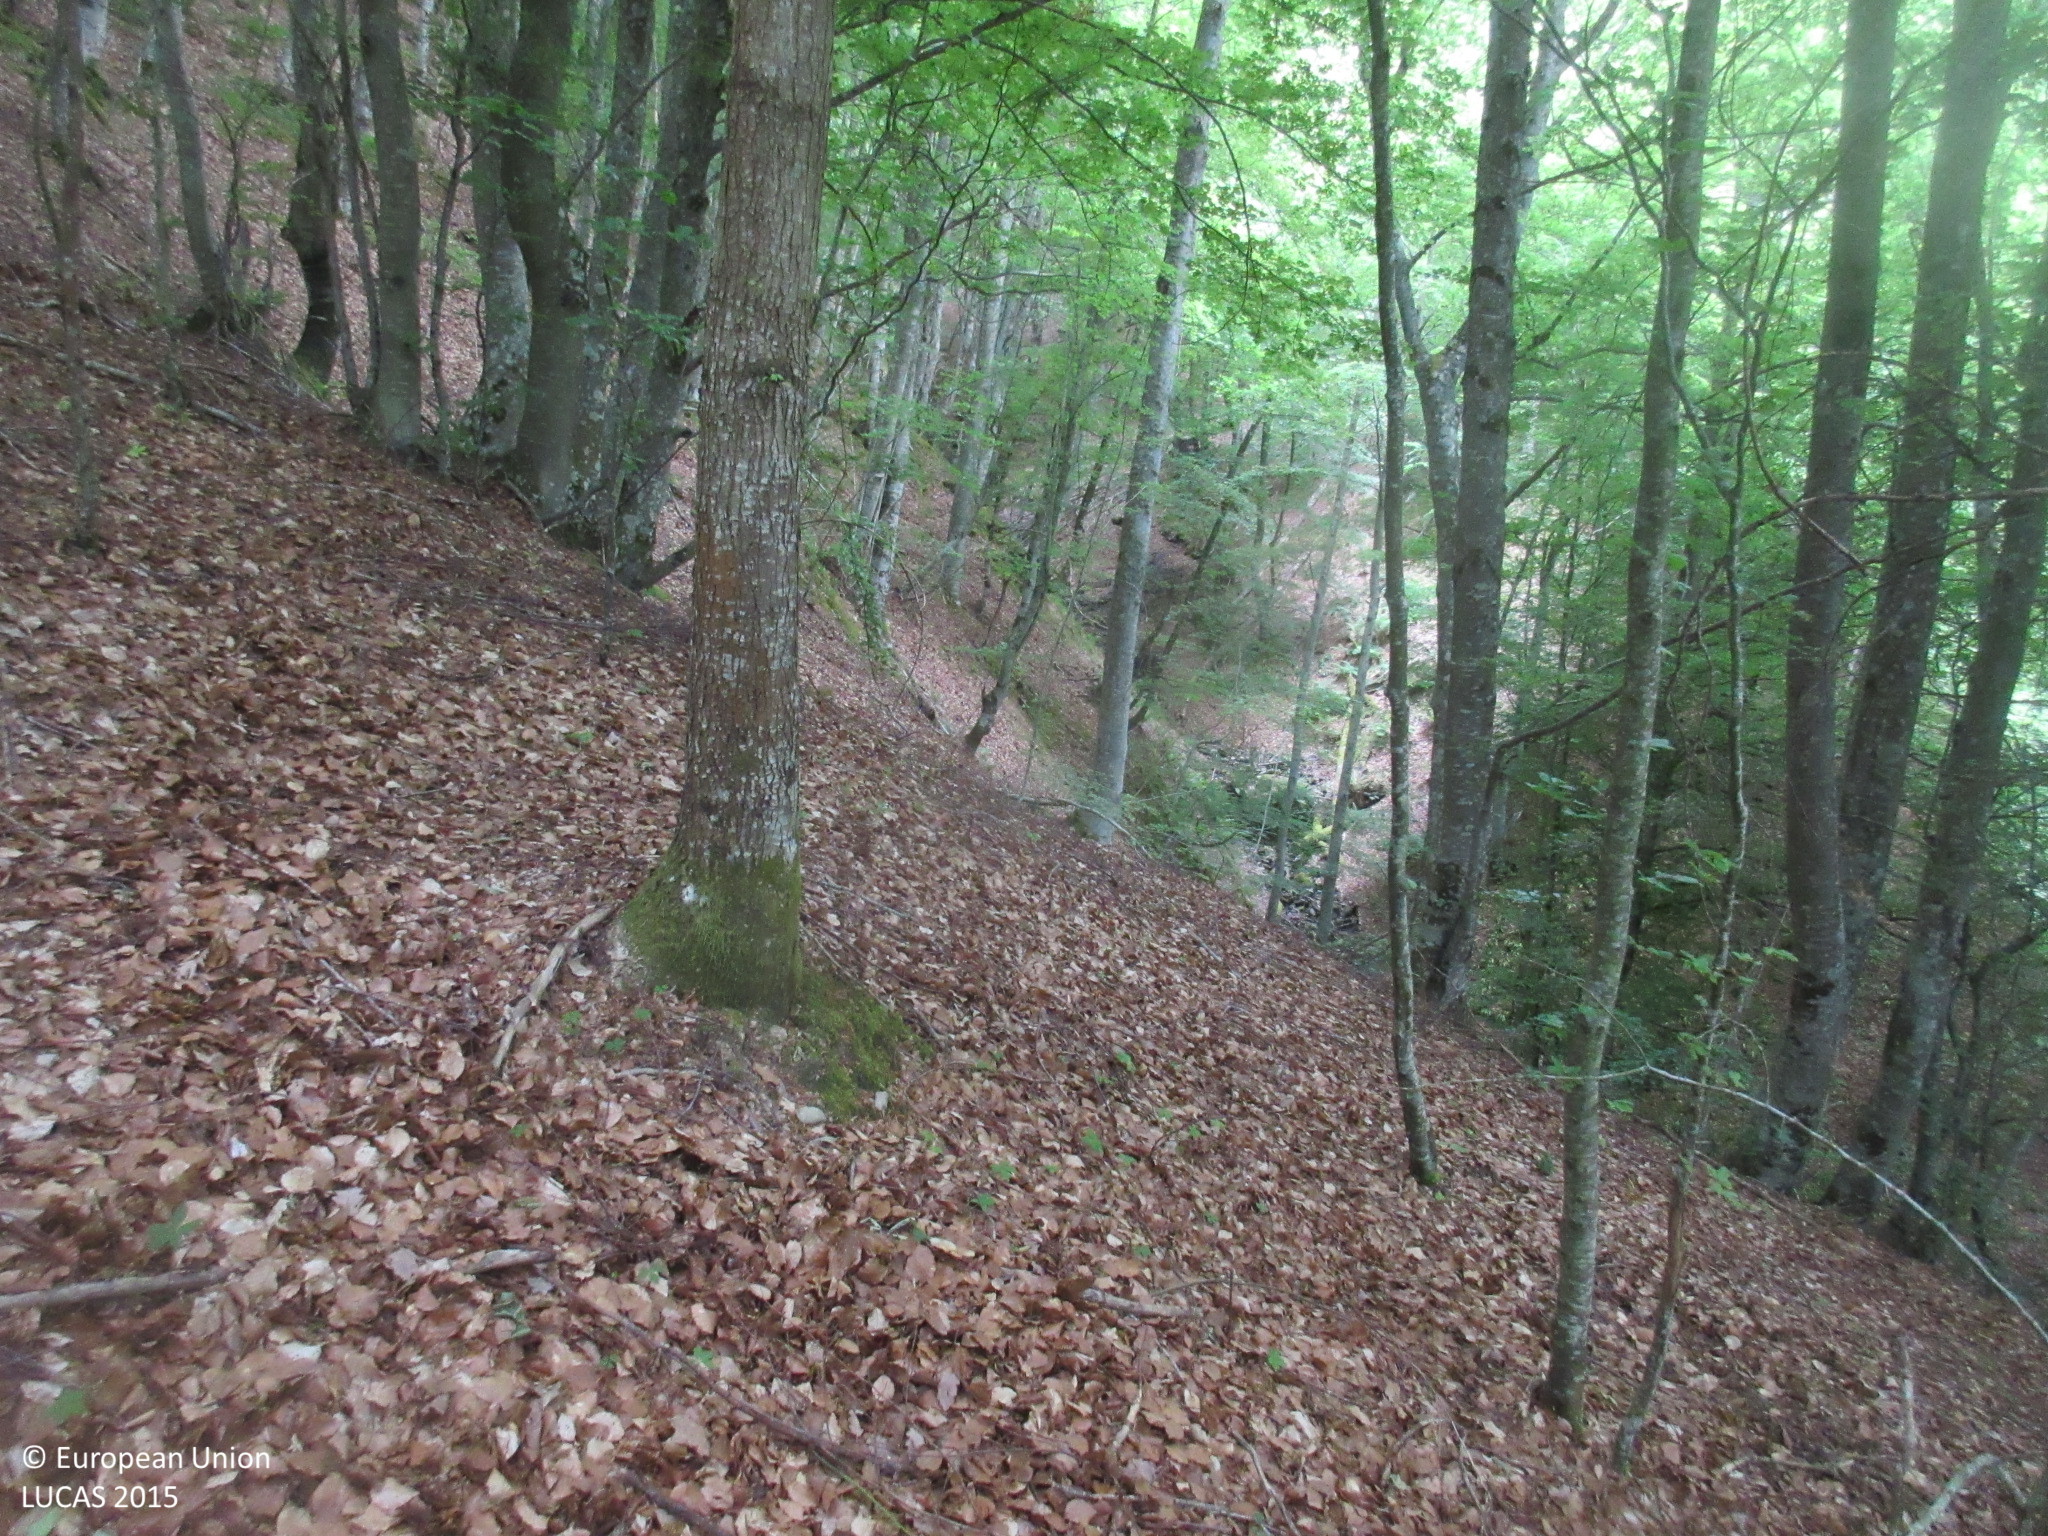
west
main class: Woodland
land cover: Broadleaved woodland
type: beech forest
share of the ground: > 75 %
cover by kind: broadleaved forest trees 100 %
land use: Semi-natural and natural areas not in use
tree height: > 5 m
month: June
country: ES
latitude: 43.0678
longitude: -4.5112
